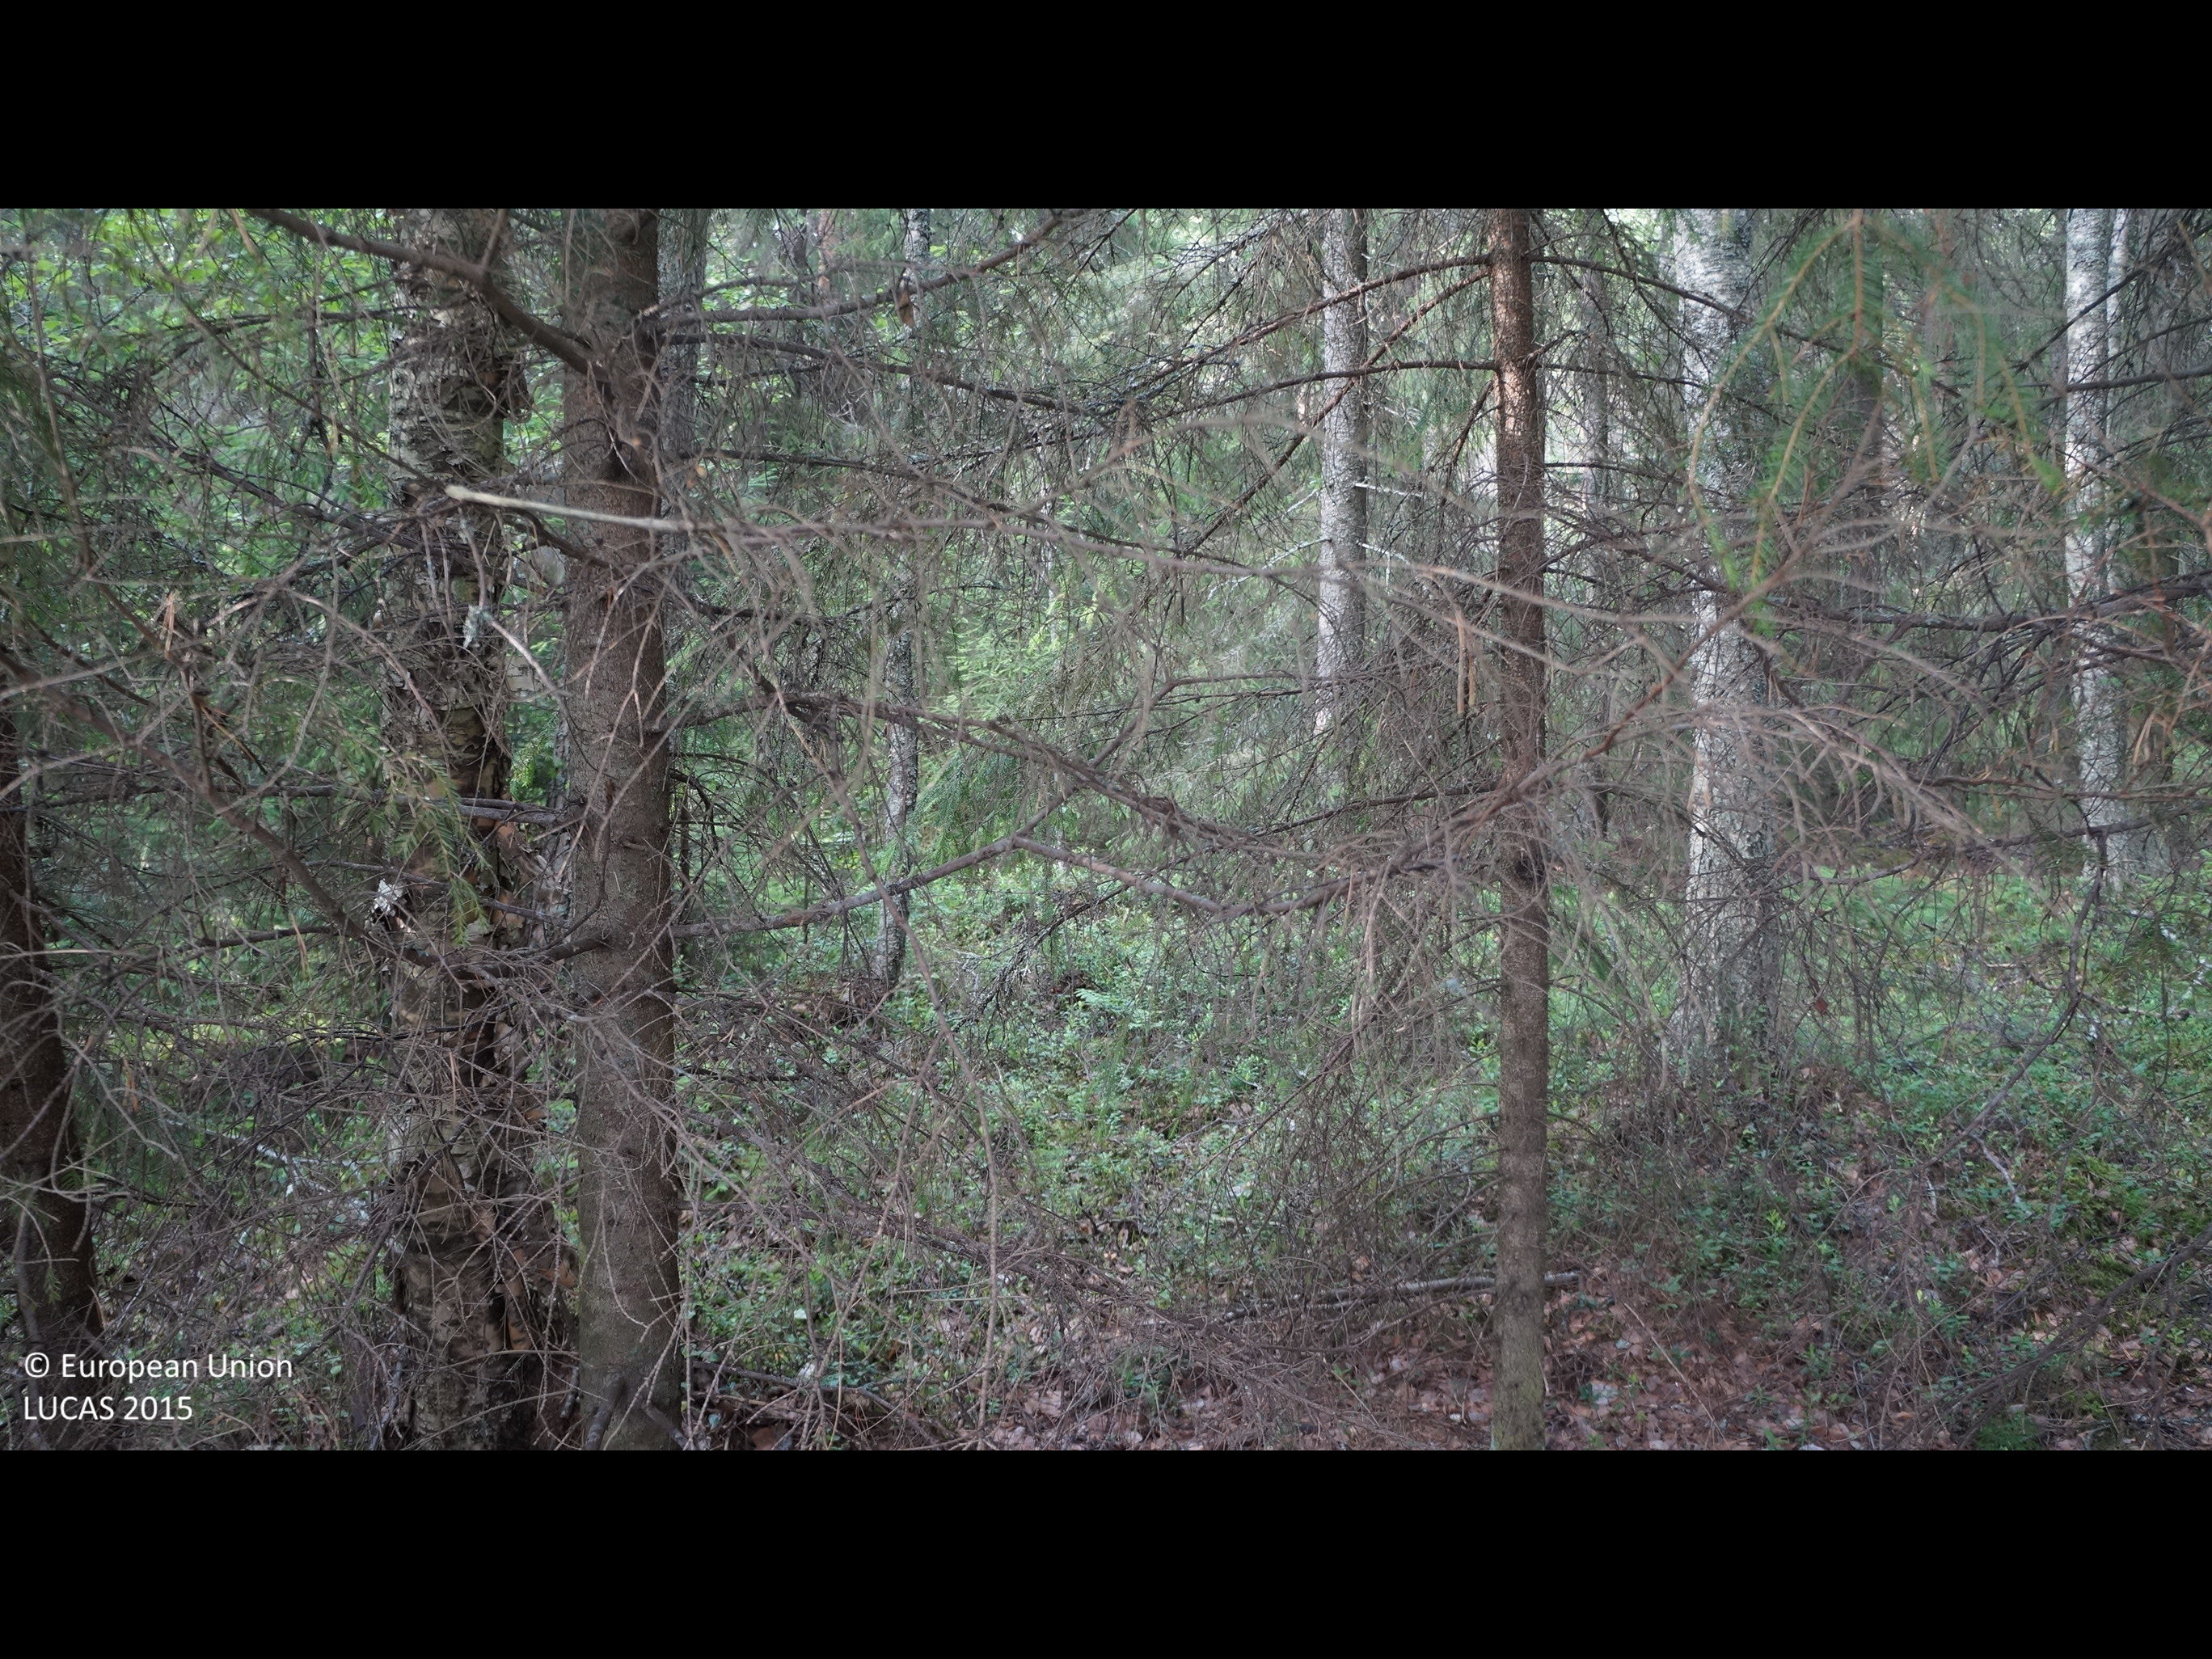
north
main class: Woodland
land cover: Spruce dominated mixed woodland
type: boreal forest
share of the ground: > 75 %
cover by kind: coniferous forest trees 50 %, broadleaved forest trees 35 %, shrubs 10 %, lichens and mosses 5 %
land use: Forestry
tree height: > 5 m
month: July
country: FI
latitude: 64.6488
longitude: 24.7031
